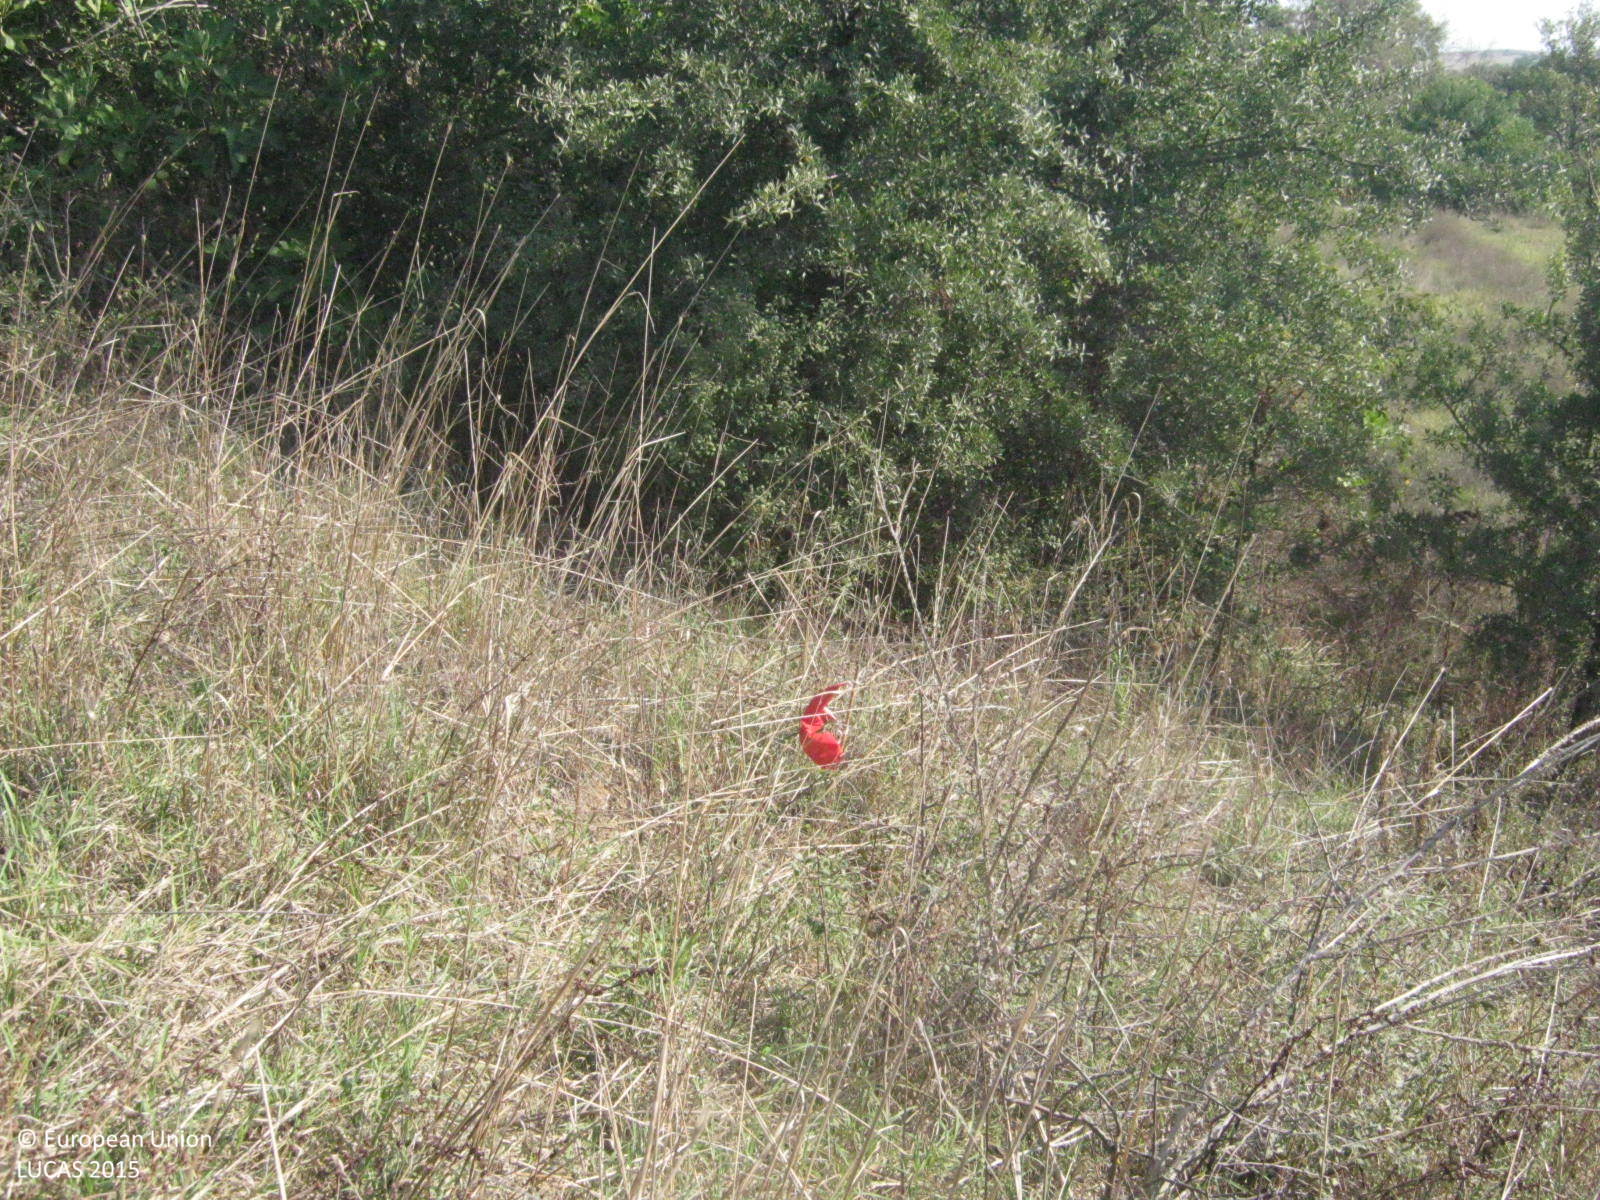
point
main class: Woodland
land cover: Broadleaved woodland
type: thermophilous deciduous forest
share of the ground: 25 - 50 %
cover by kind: broadleaved forest trees 50 %, herbaceous plants 30 %, shrubs 20 %
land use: Semi-natural and natural areas not in use
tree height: < 5 m
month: August
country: GR
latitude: 41.0946
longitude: 22.6165
